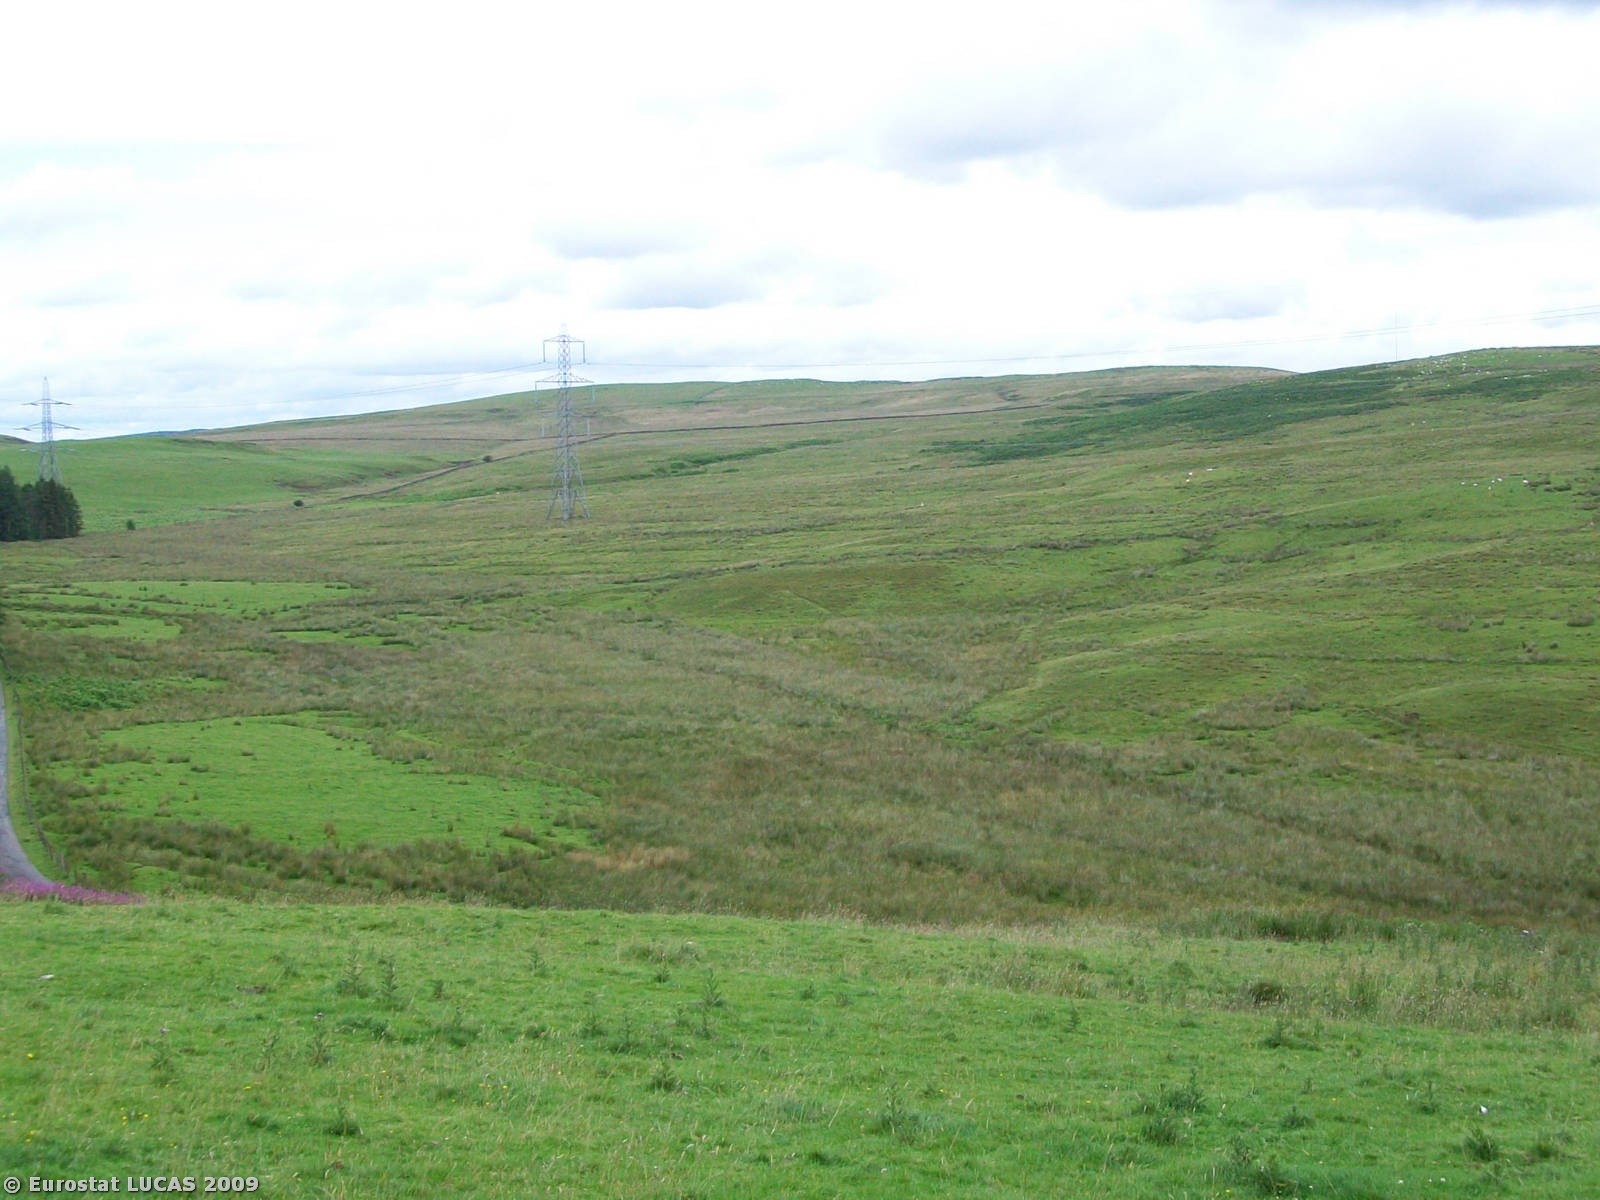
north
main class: Grassland
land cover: Grassland without tree/shrub cover
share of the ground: > 75 %
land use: Agriculture (excluding fallow land and kitchen gardens)
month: July
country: GB
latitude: 55.1619
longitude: -3.3085
